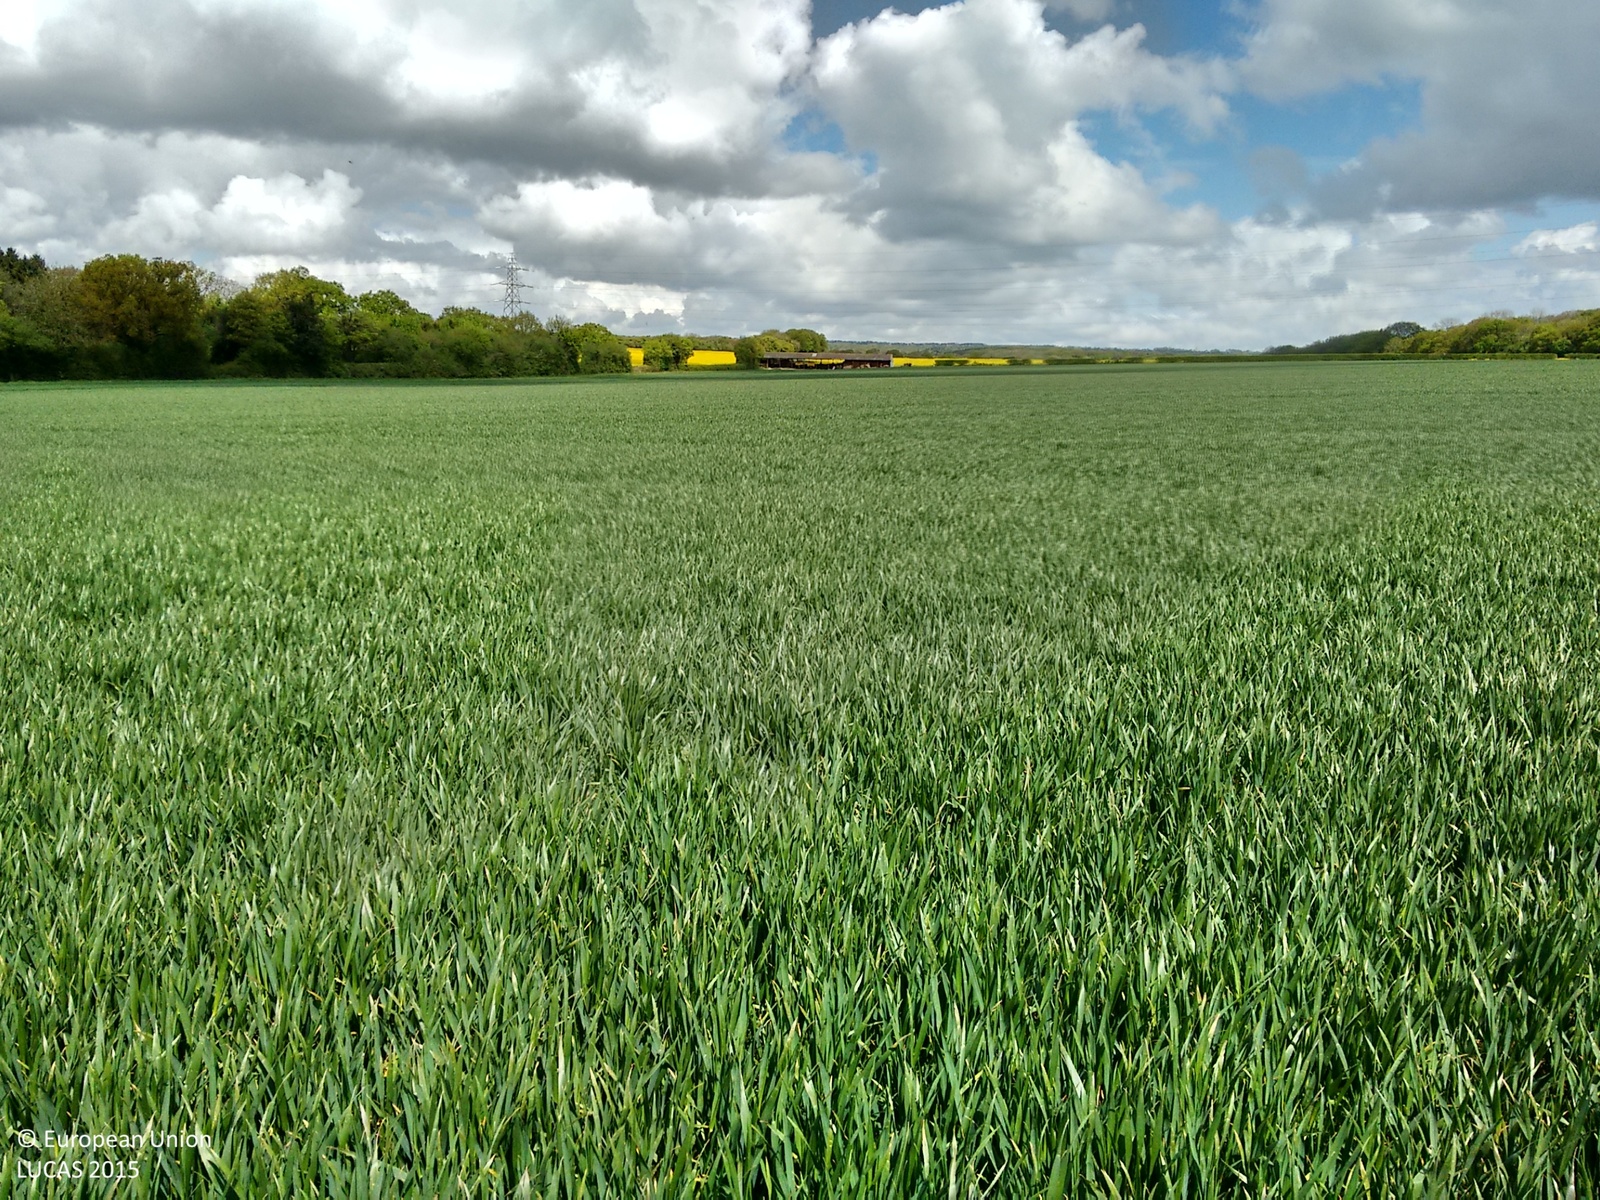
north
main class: Cropland
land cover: Common wheat
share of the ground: > 75 %
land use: Agriculture (excluding fallow land and kitchen gardens)
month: May
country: GB
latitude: 51.2328
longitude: -1.5231
